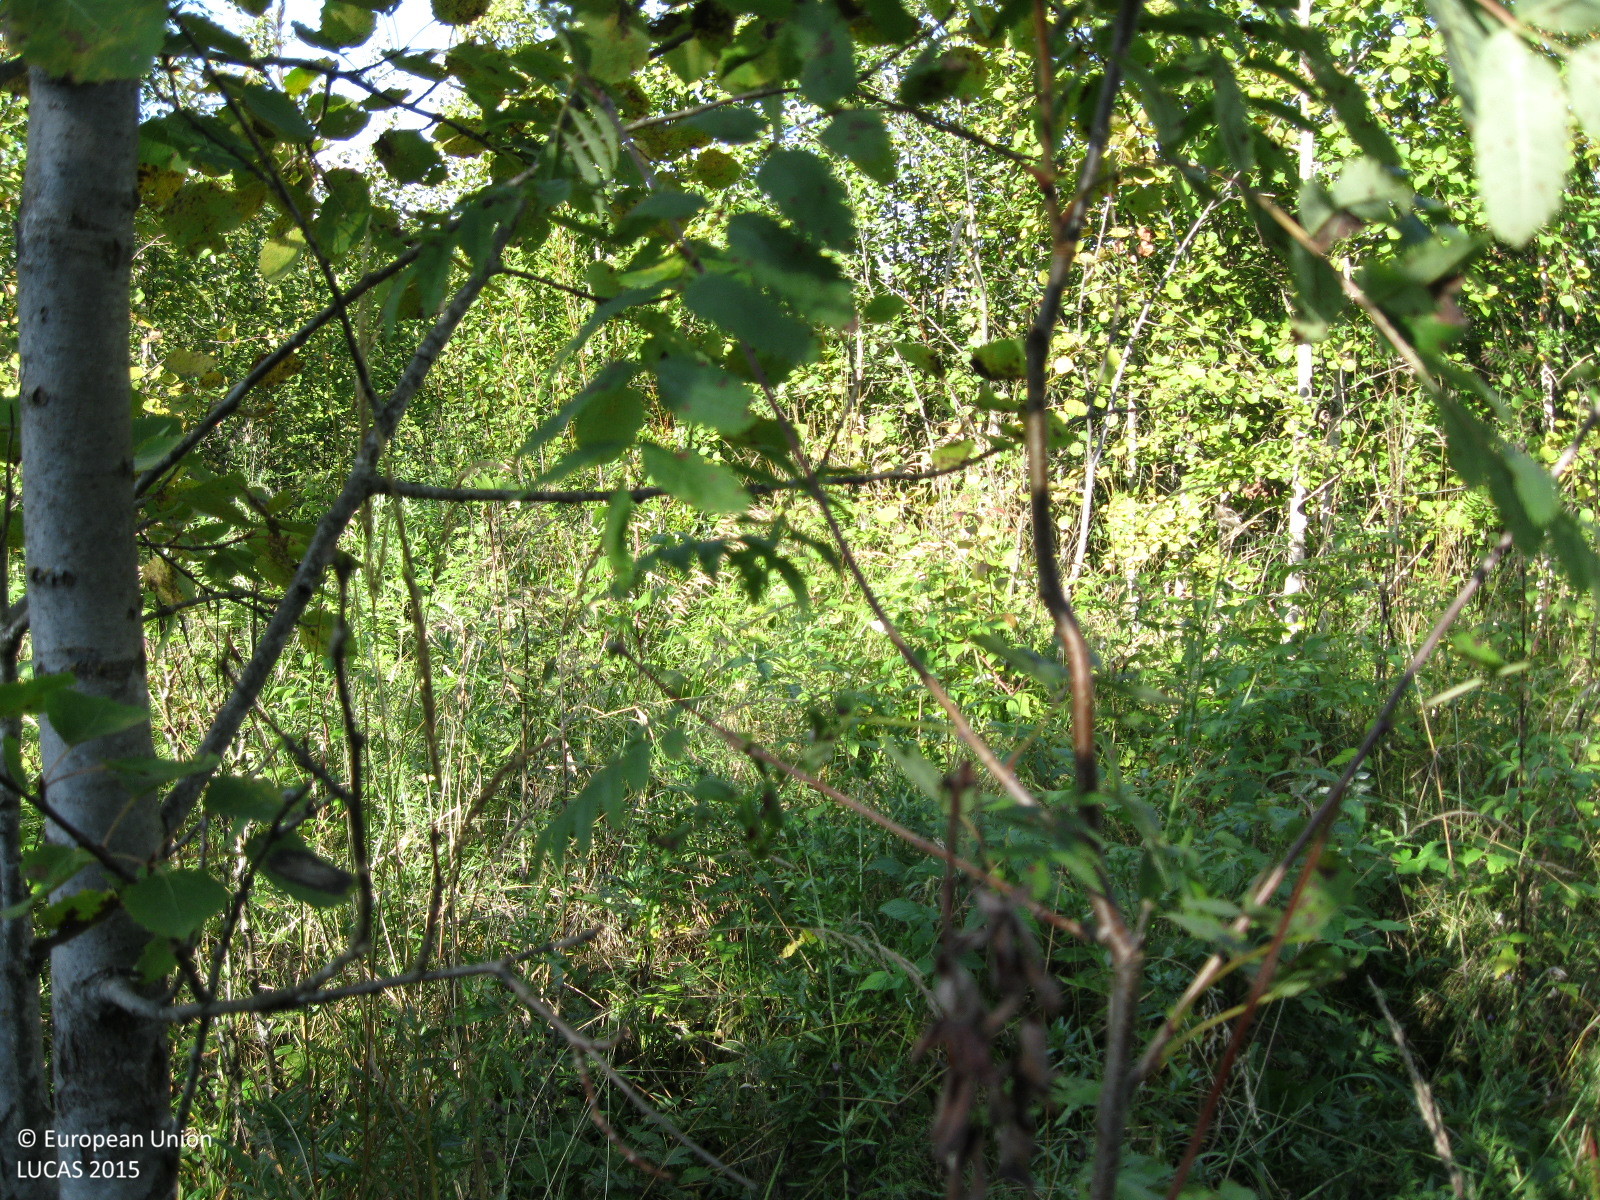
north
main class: Woodland
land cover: Broadleaved woodland
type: boreal forest
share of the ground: > 75 %
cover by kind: broadleaved forest trees 80 %, herbaceous plants 15 %, coniferous forest trees 5 %
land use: Forestry
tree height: > 5 m
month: September
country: FI
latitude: 60.5092
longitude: 24.8463
